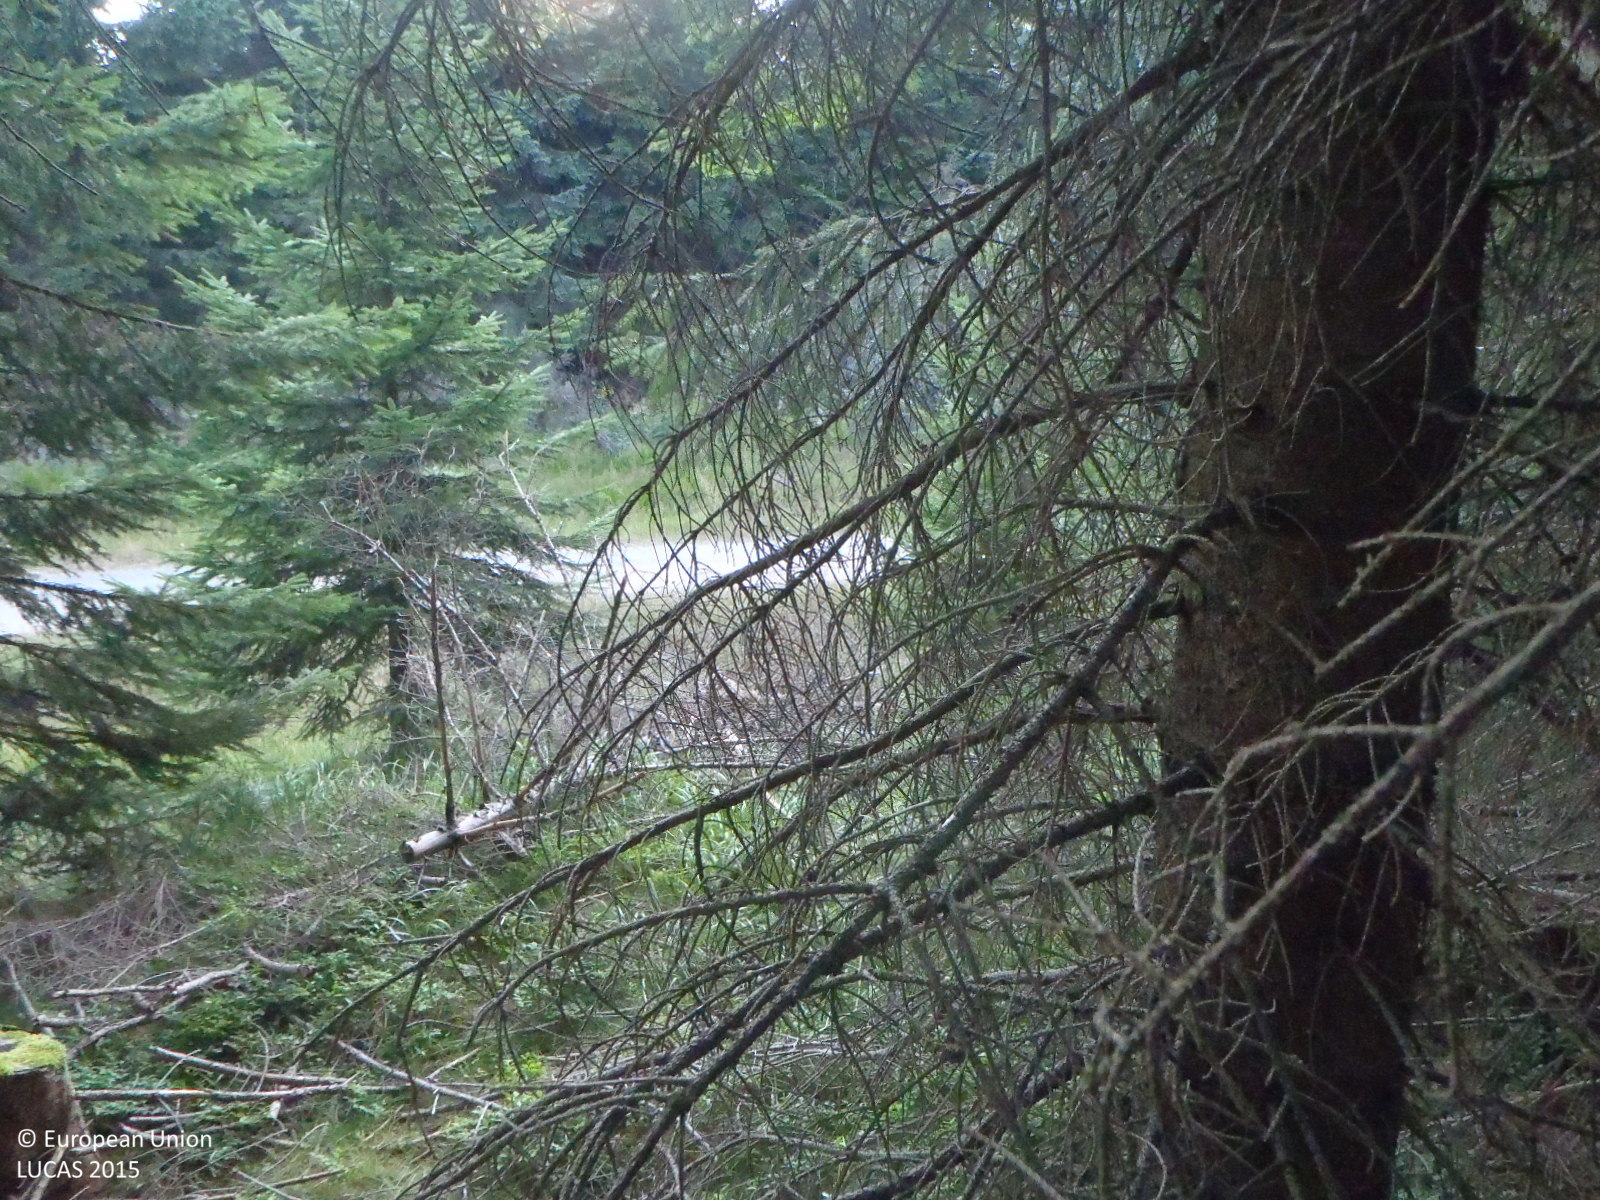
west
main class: Woodland
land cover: Spruce dominated coniferous woodland
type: hemiboreal forest and nemoral coniferous forest and mixed broadleaved-coniferous forest
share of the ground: > 75 %
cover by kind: coniferous forest trees 80 %, shrubs 10 %, herbaceous plants 10 %
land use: Forestry
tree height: > 5 m
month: August
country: CZ
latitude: 50.8551
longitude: 15.2738
